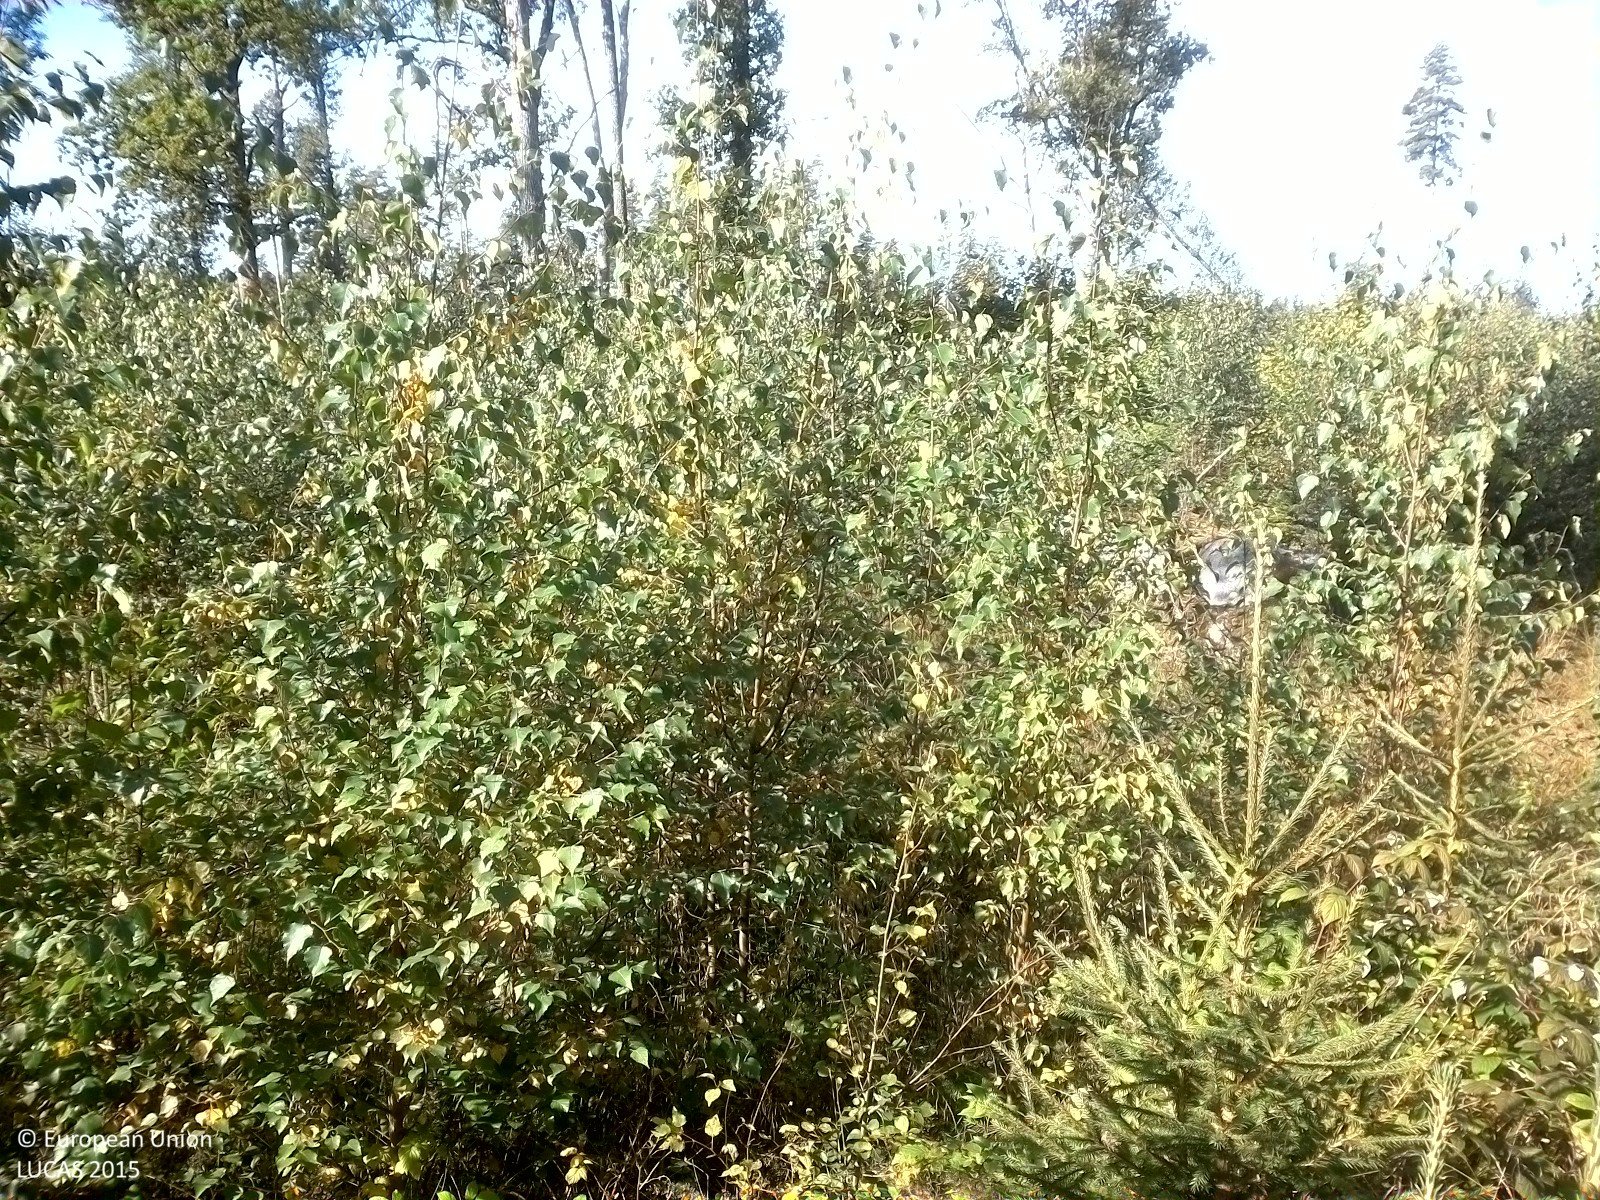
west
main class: Woodland
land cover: Spruce dominated mixed woodland
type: boreal forest
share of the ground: 25 - 50 %
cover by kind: herbaceous plants 40 %, coniferous forest trees 20 %, broadleaved forest trees 20 %, shrubs 10 %, lichens and mosses 10 %
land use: Forestry
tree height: < 5 m
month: September
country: SE
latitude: 59.0371
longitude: 15.6912
